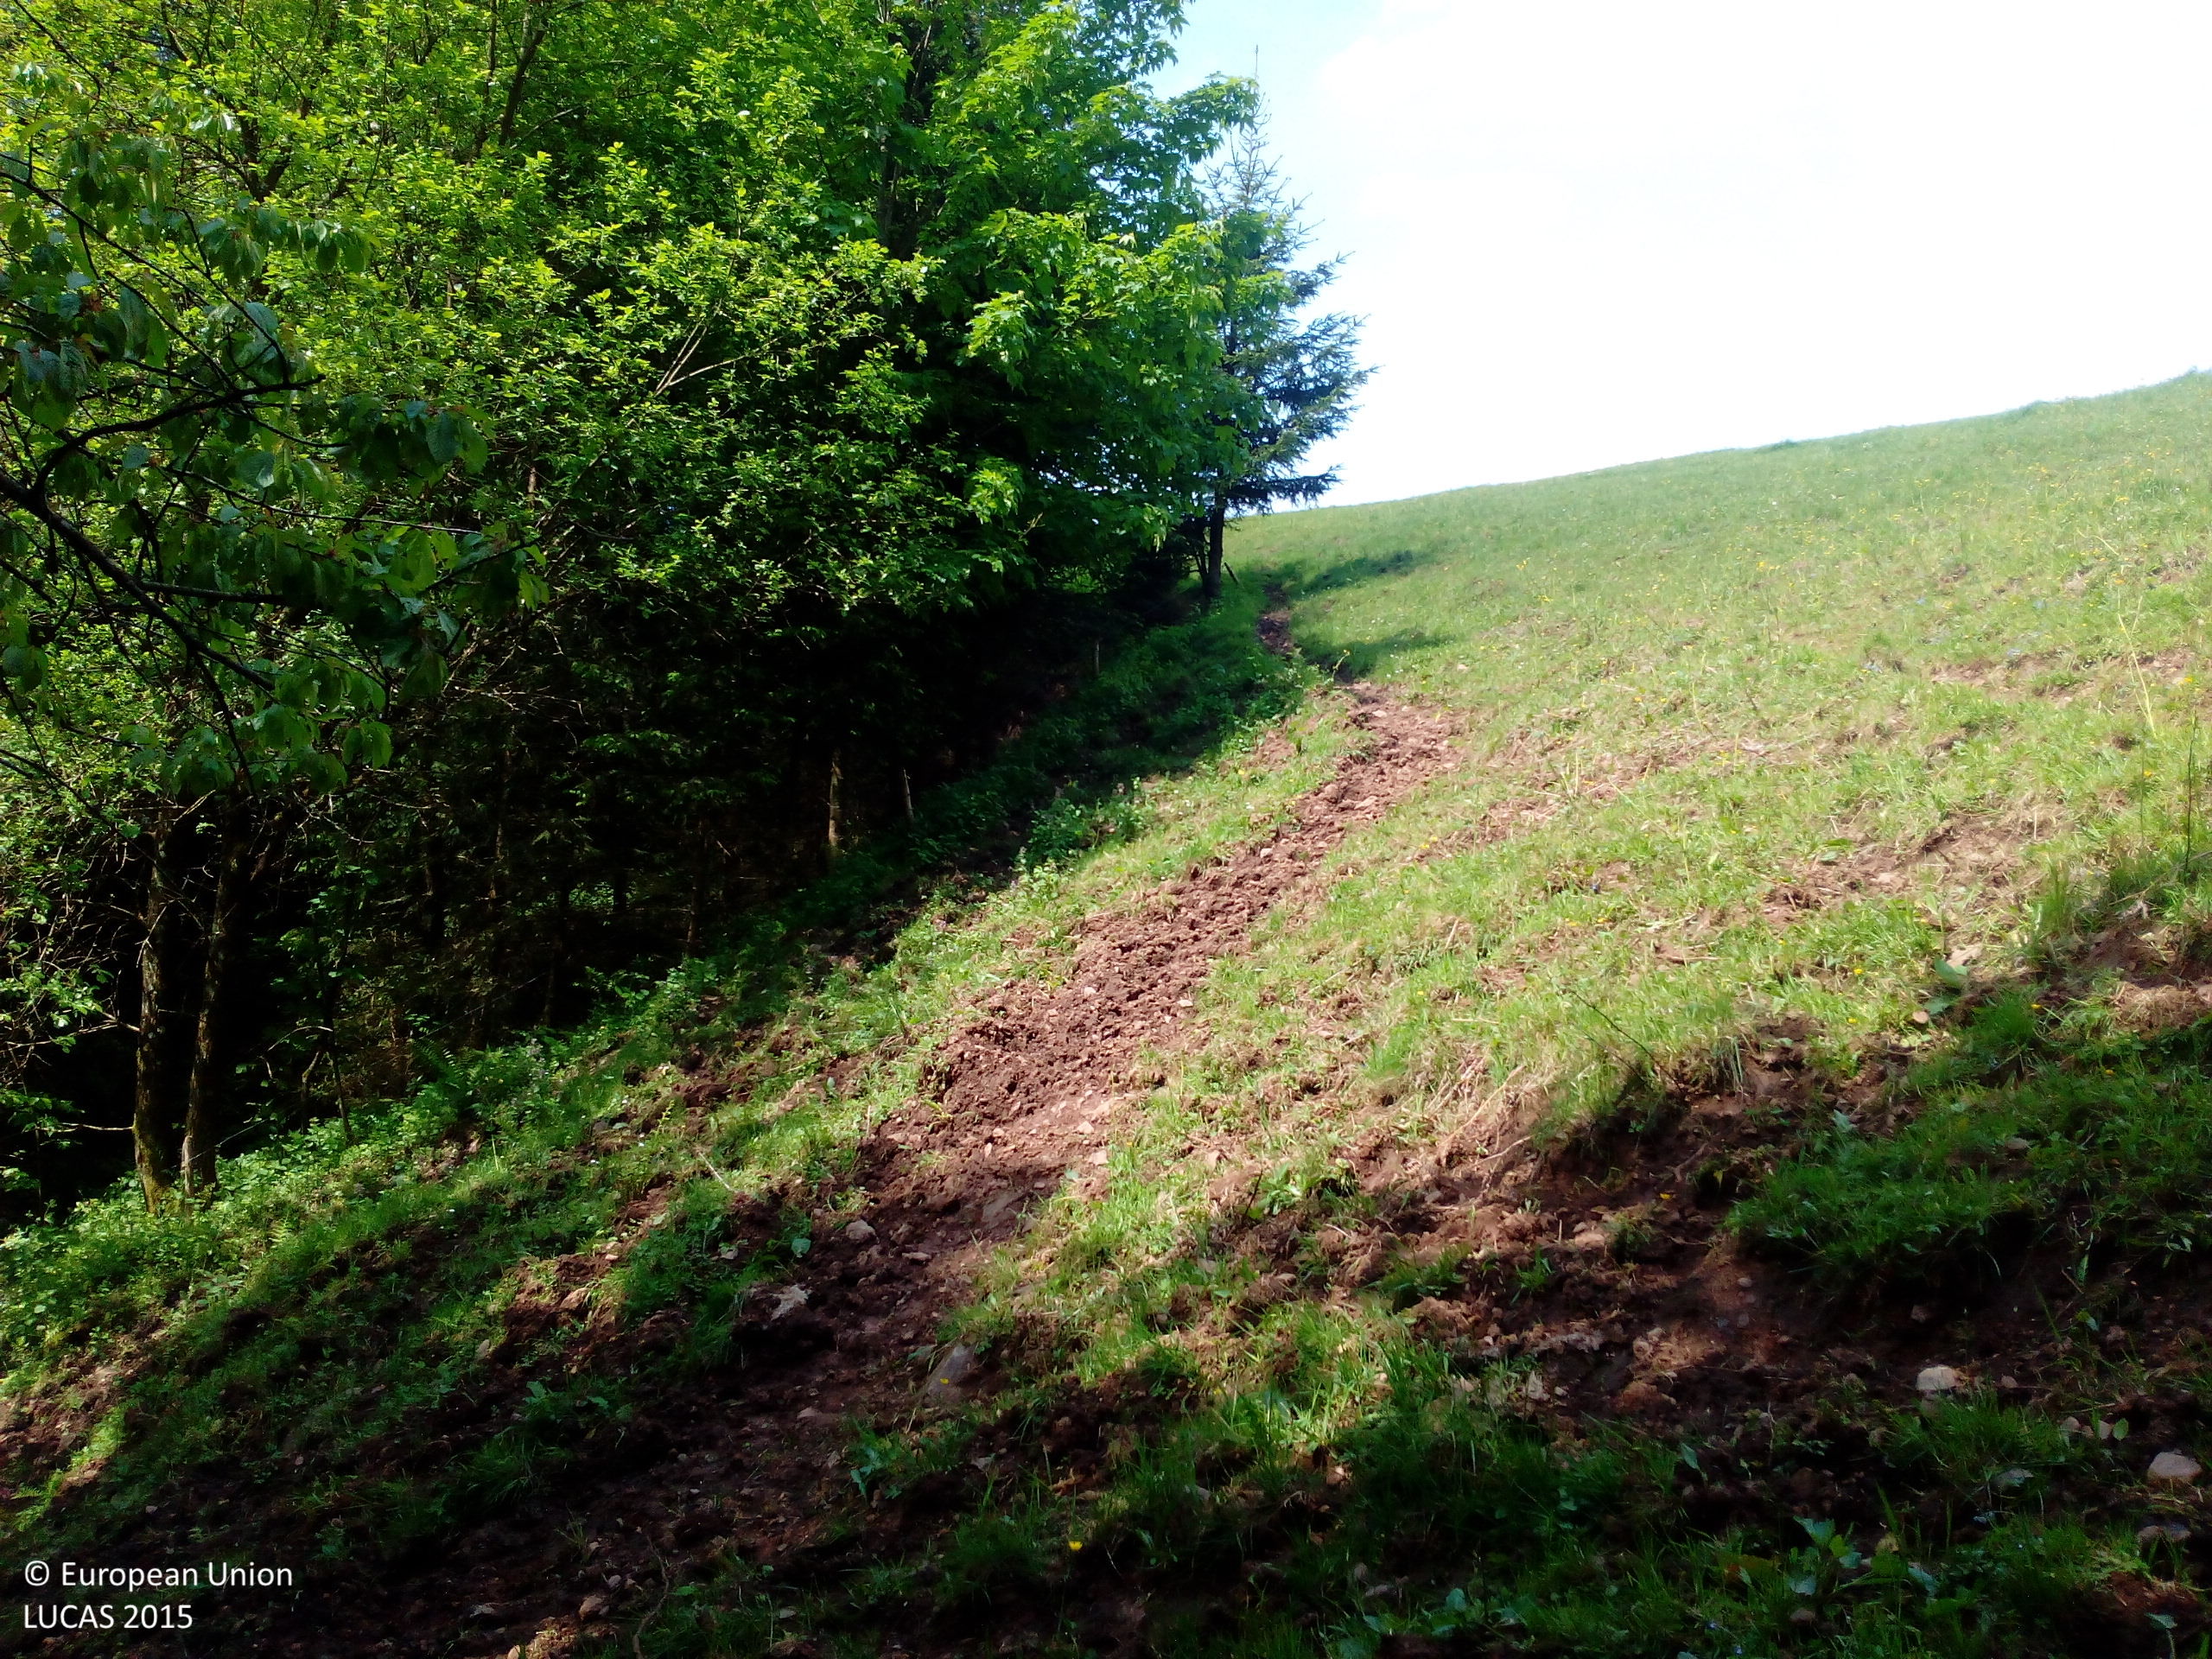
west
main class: Grassland
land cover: Grassland without tree/shrub cover
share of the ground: 25 - 50 %
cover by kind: unconsolidated bare surface 55 %, herbaceous plants 45 %
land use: Agriculture (excluding fallow land and kitchen gardens)
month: May
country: DE
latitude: 48.0094
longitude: 8.1110
